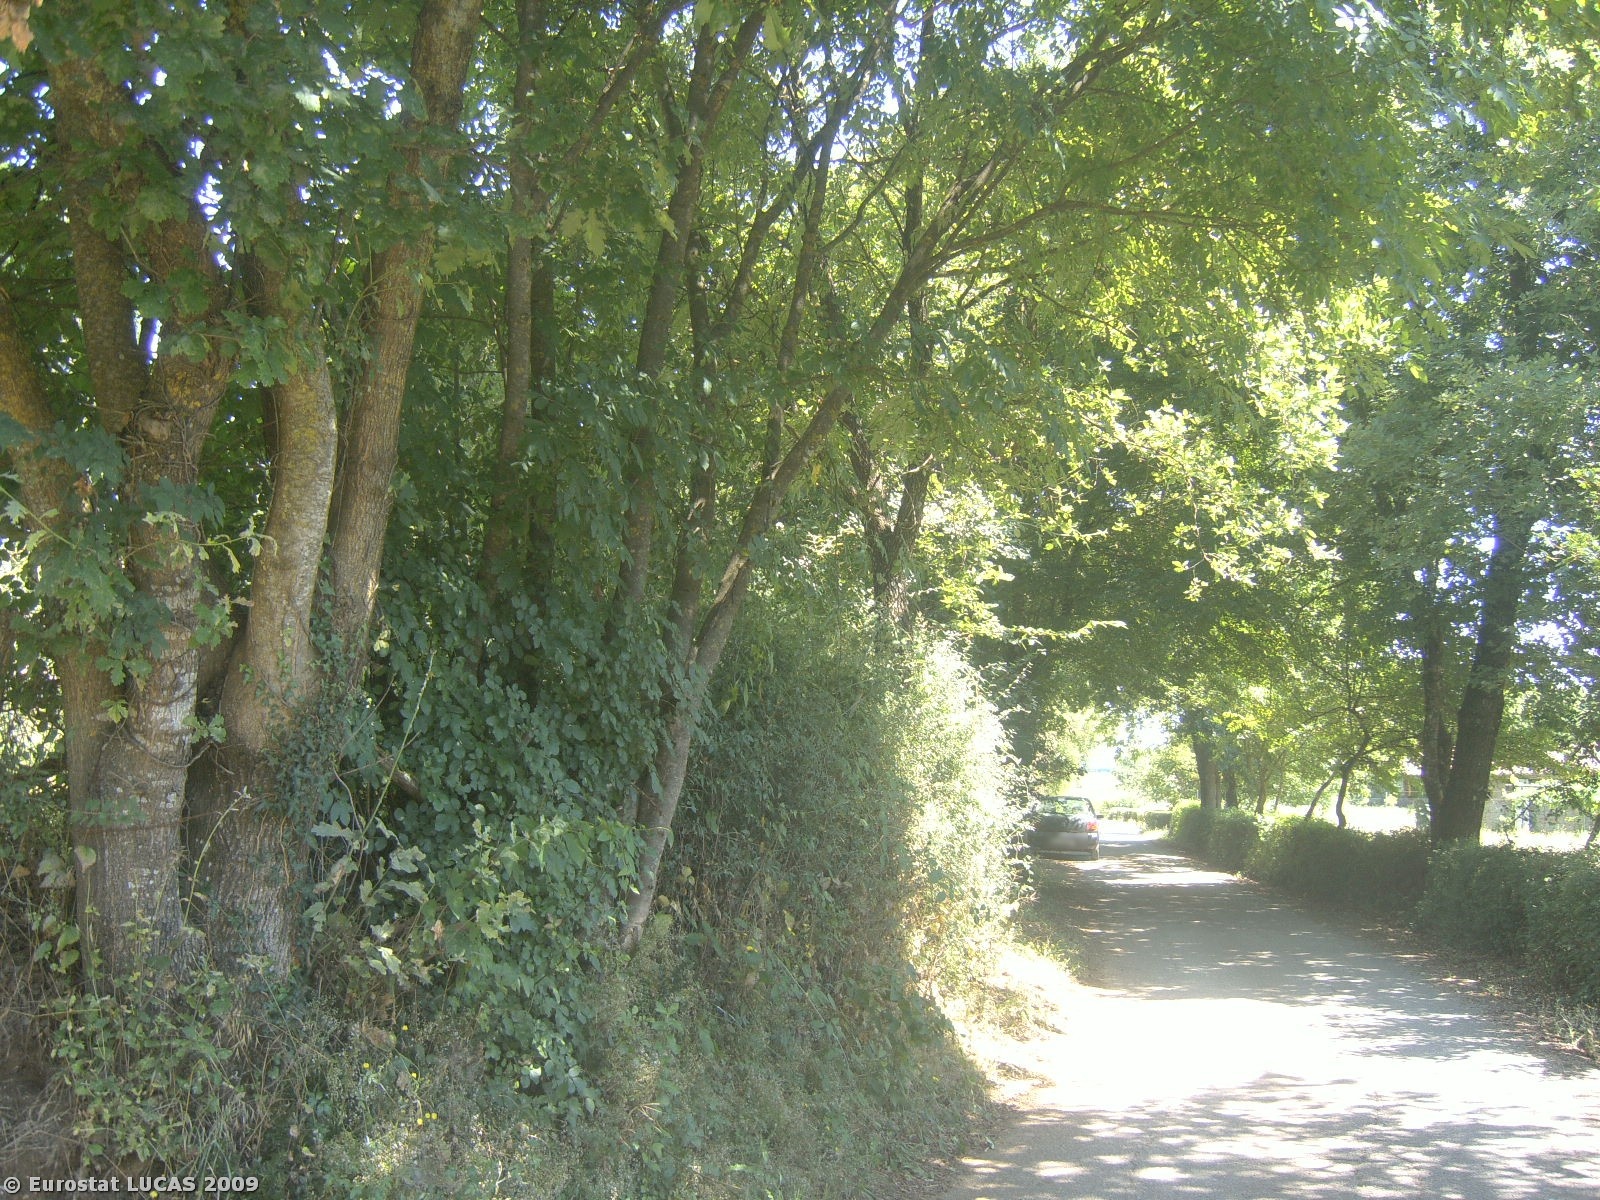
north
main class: Cropland
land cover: Other fresh vegetables
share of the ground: > 75 %
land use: Kitchen garden
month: July
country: IT
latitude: 41.6069
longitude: 13.2633
